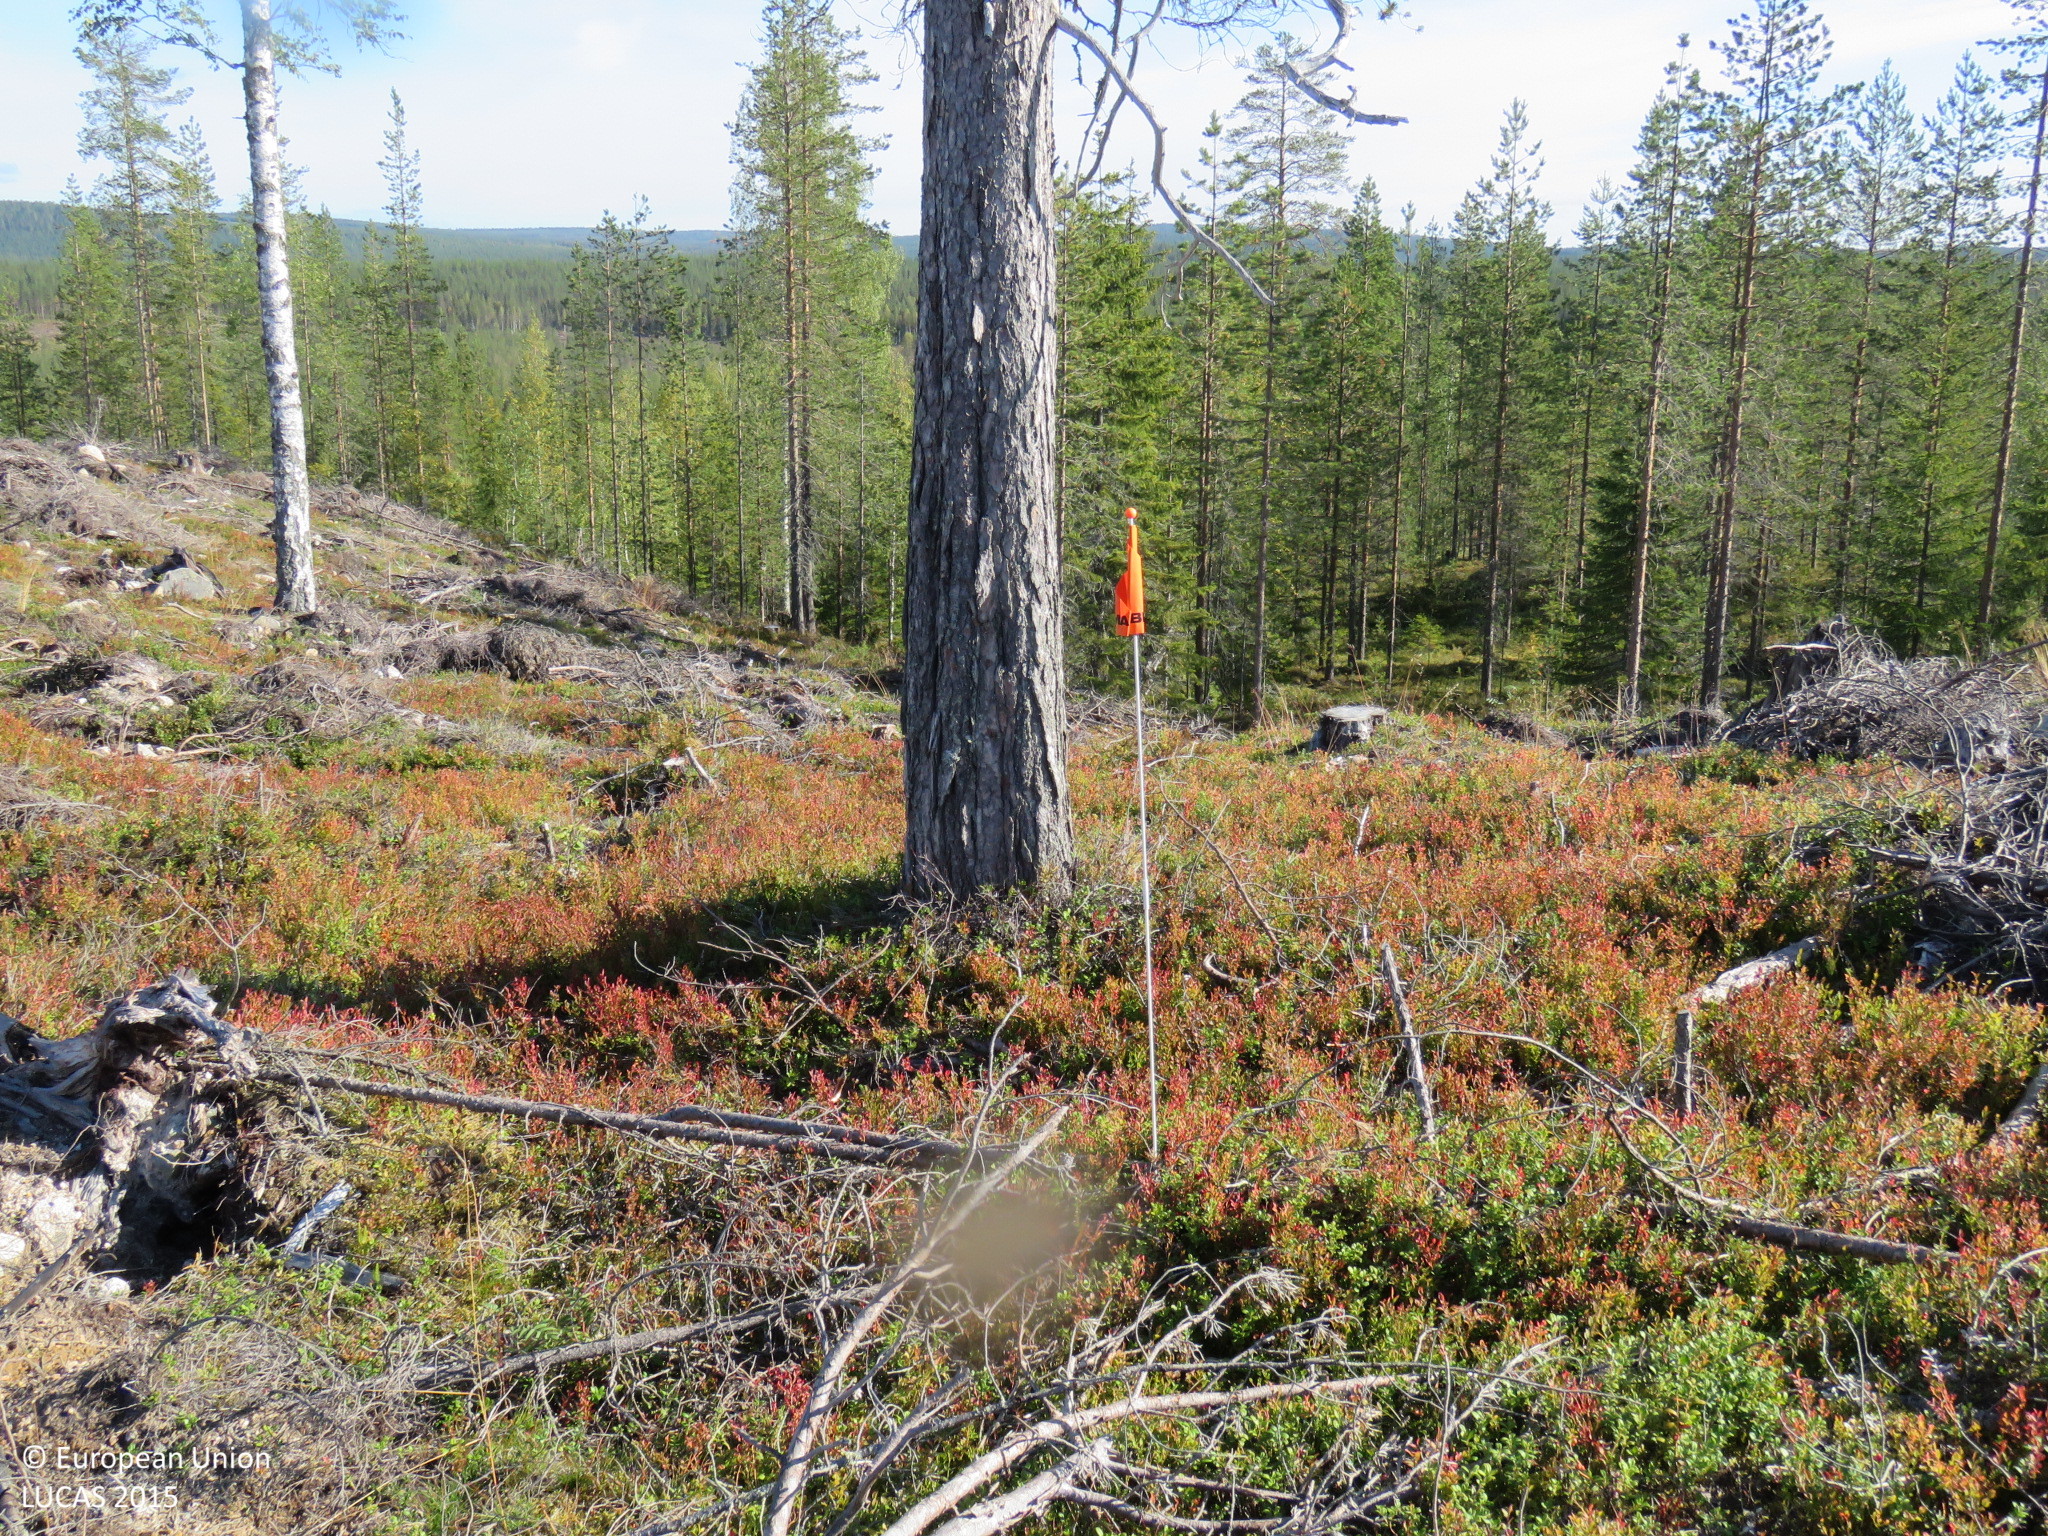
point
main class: Shrubland
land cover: Shrubland with sparse tree cover
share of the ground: 25 - 50 %
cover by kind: shrubs 40 %, consolidated bare surface 20 %, lichens and mosses 15 %, herbaceous plants 10 %, coniferous forest trees 5 %
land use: Forestry
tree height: > 5 m
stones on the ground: 10 - 25 %
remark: Clear cut
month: September
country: FI
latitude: 65.5048
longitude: 27.6195
